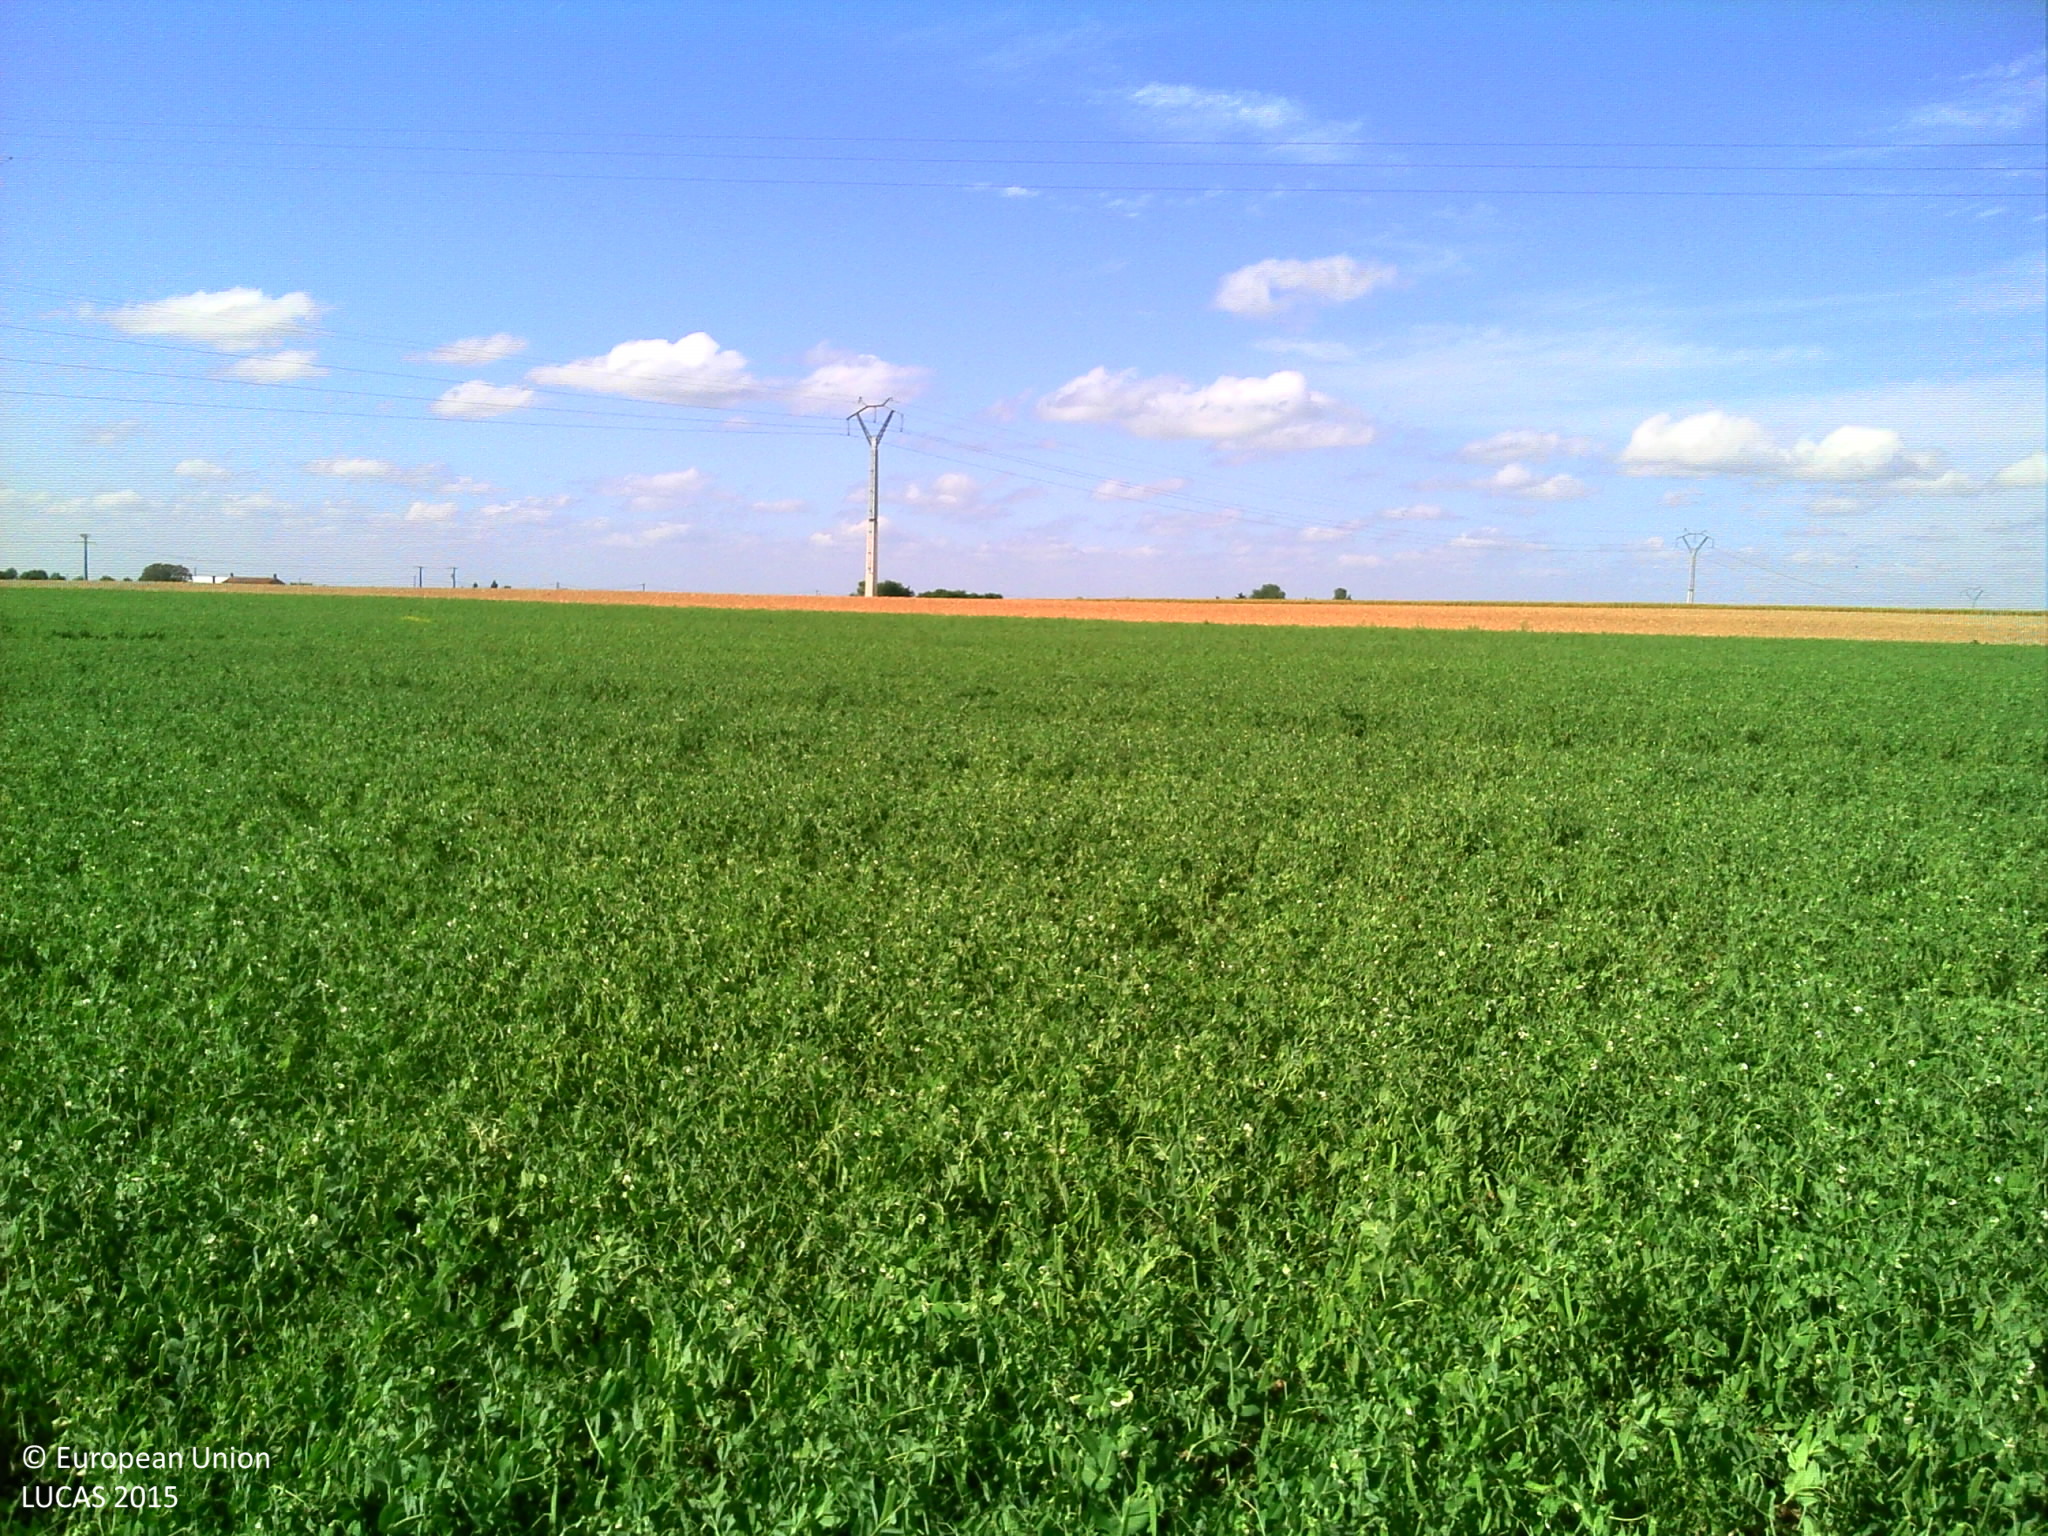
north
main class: Cropland
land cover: Dry pulses
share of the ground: > 75 %
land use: Agriculture (excluding fallow land and kitchen gardens)
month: June
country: FR
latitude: 46.2936
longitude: -0.9737
